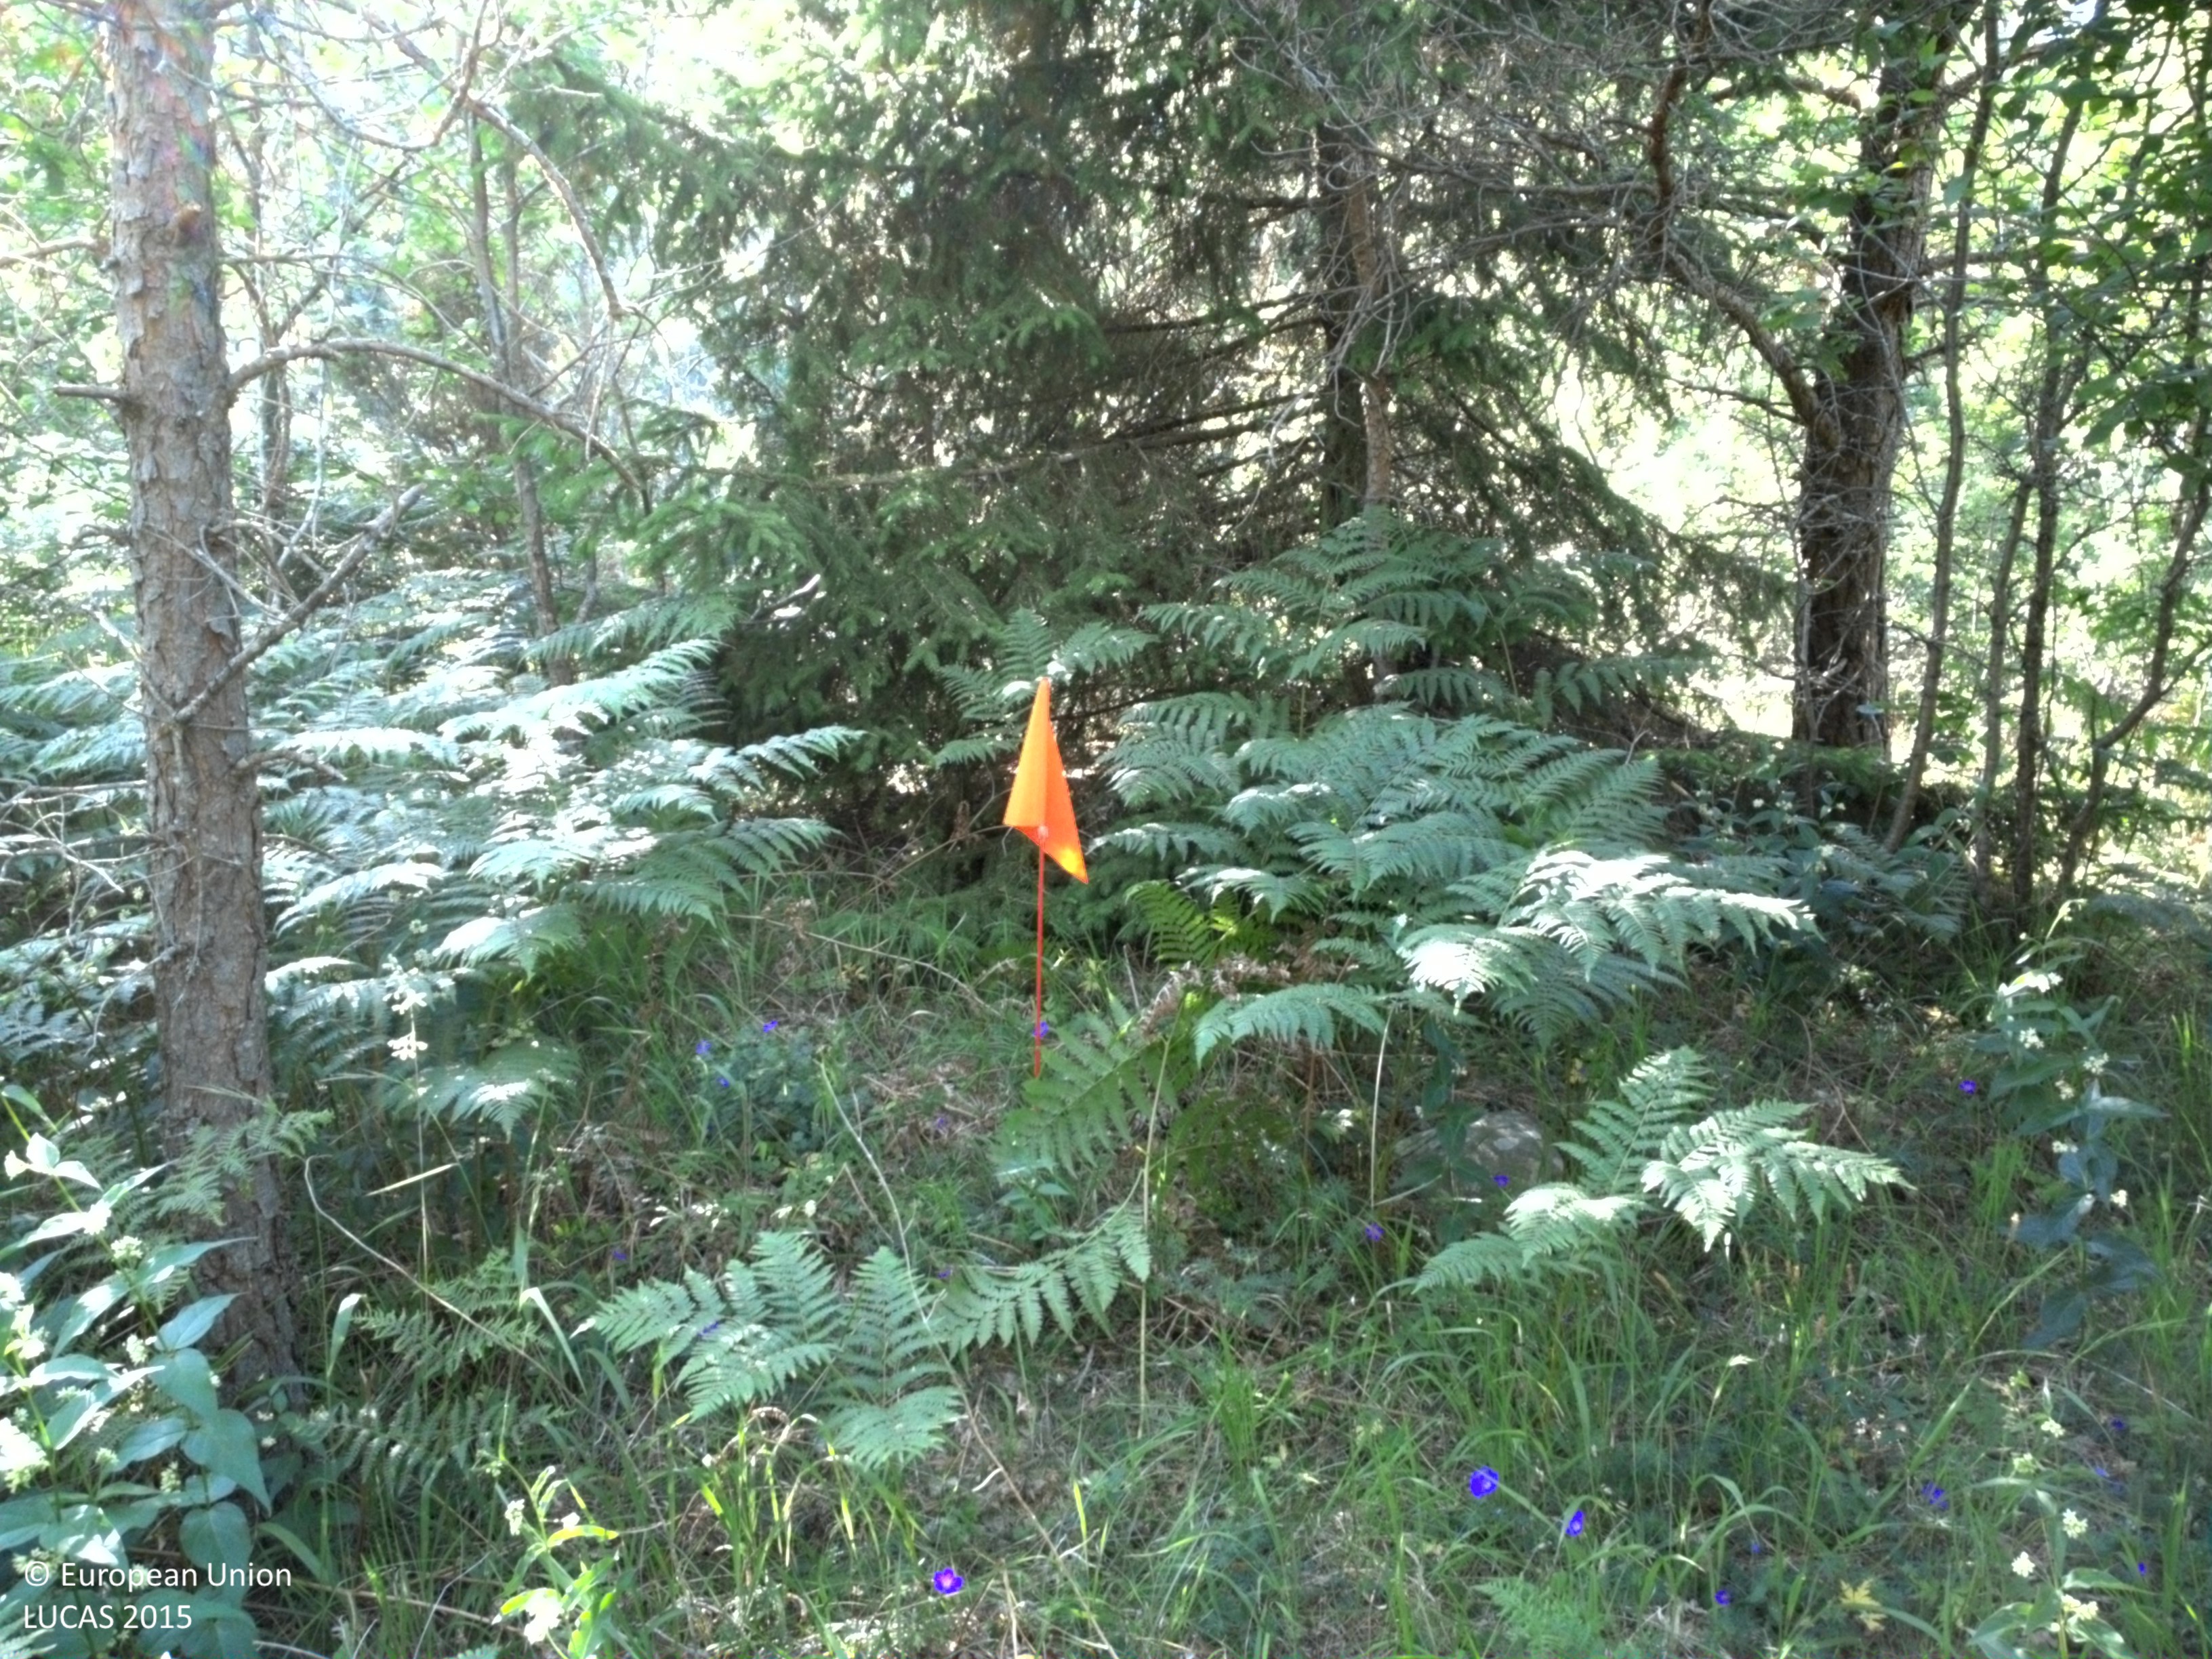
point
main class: Woodland
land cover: Pine dominated mixed woodland
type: hemiboreal forest and nemoral coniferous forest and mixed broadleaved-coniferous forest
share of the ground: > 75 %
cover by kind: coniferous forest trees 45 %, broadleaved forest trees 30 %, shrubs 15 %, herbaceous plants 10 %
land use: Semi-natural and natural areas not in use
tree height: > 5 m
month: July
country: SE
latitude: 57.7653
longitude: 18.8348
